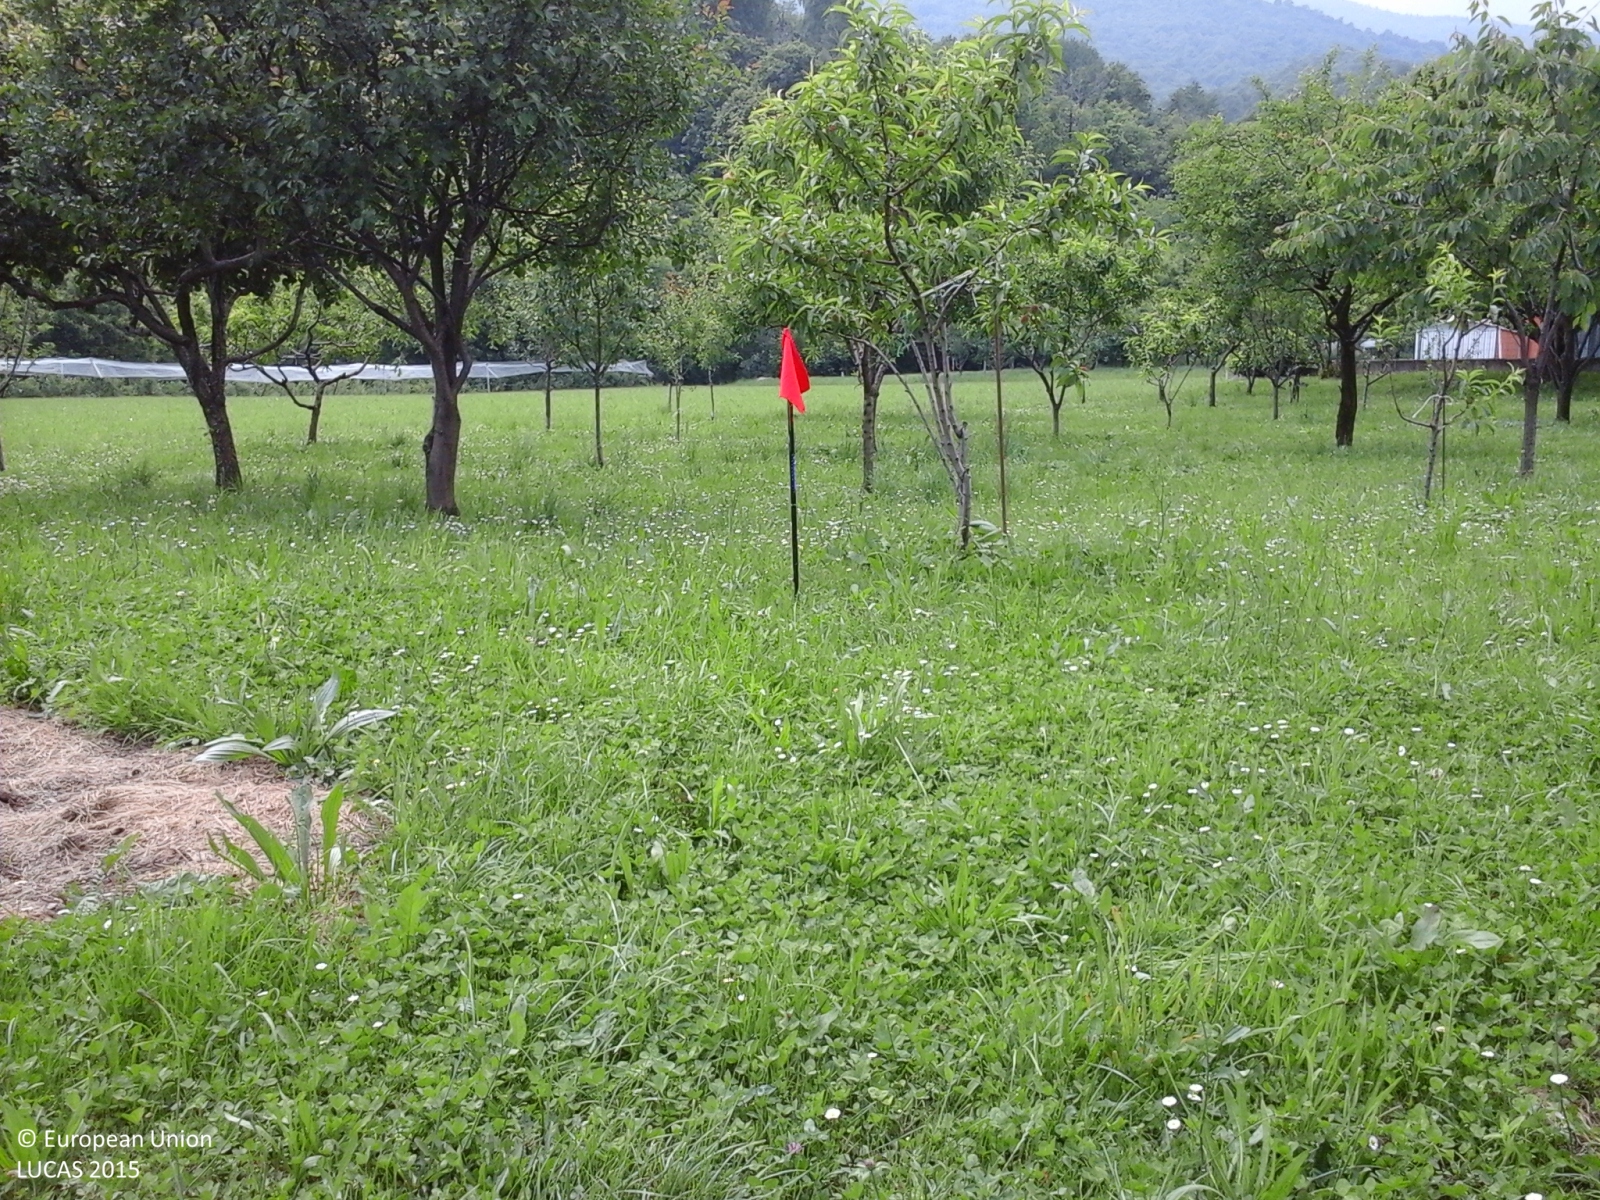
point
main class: Grassland
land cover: Grassland with sparse tree/shrub cover
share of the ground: > 75 %
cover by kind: herbaceous plants 95 %, broadleaved forest trees 5 %
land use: Agriculture (excluding fallow land and kitchen gardens)
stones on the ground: < 10 %
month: May
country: IT
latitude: 44.7302
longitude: 7.2903
